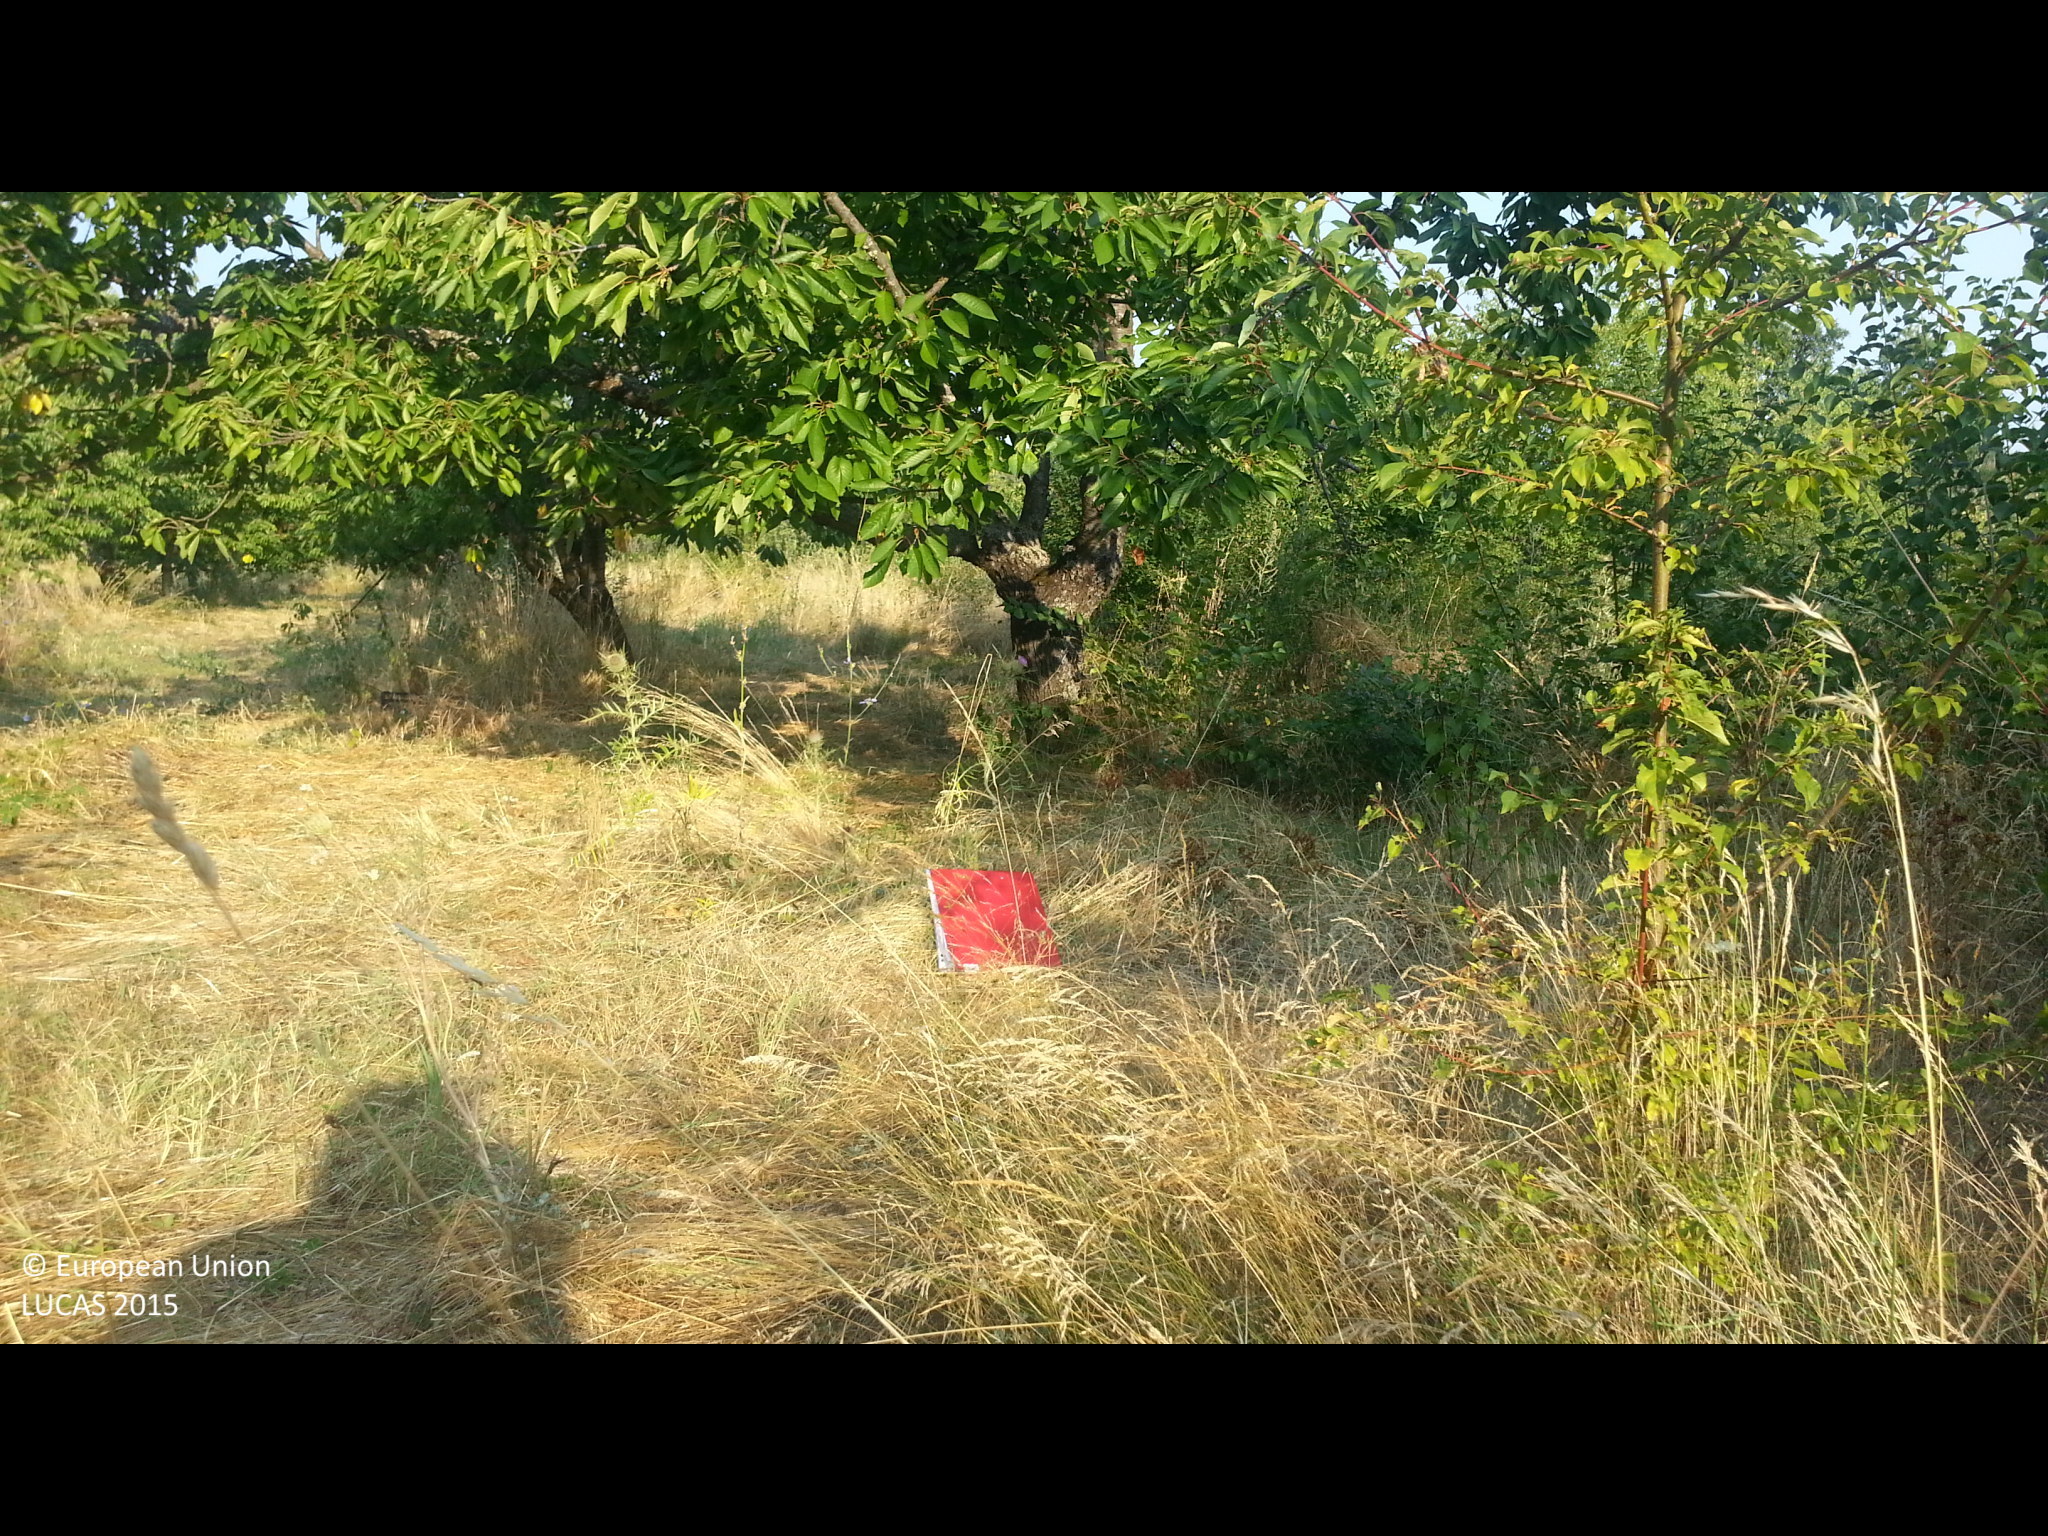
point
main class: Cropland
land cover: Cherry fruit
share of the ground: > 75 %
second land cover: Spontaneously vegetated surfaces
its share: > 75 %
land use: Agriculture (excluding fallow land and kitchen gardens)
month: August
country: BG
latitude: 42.4025
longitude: 22.6704
